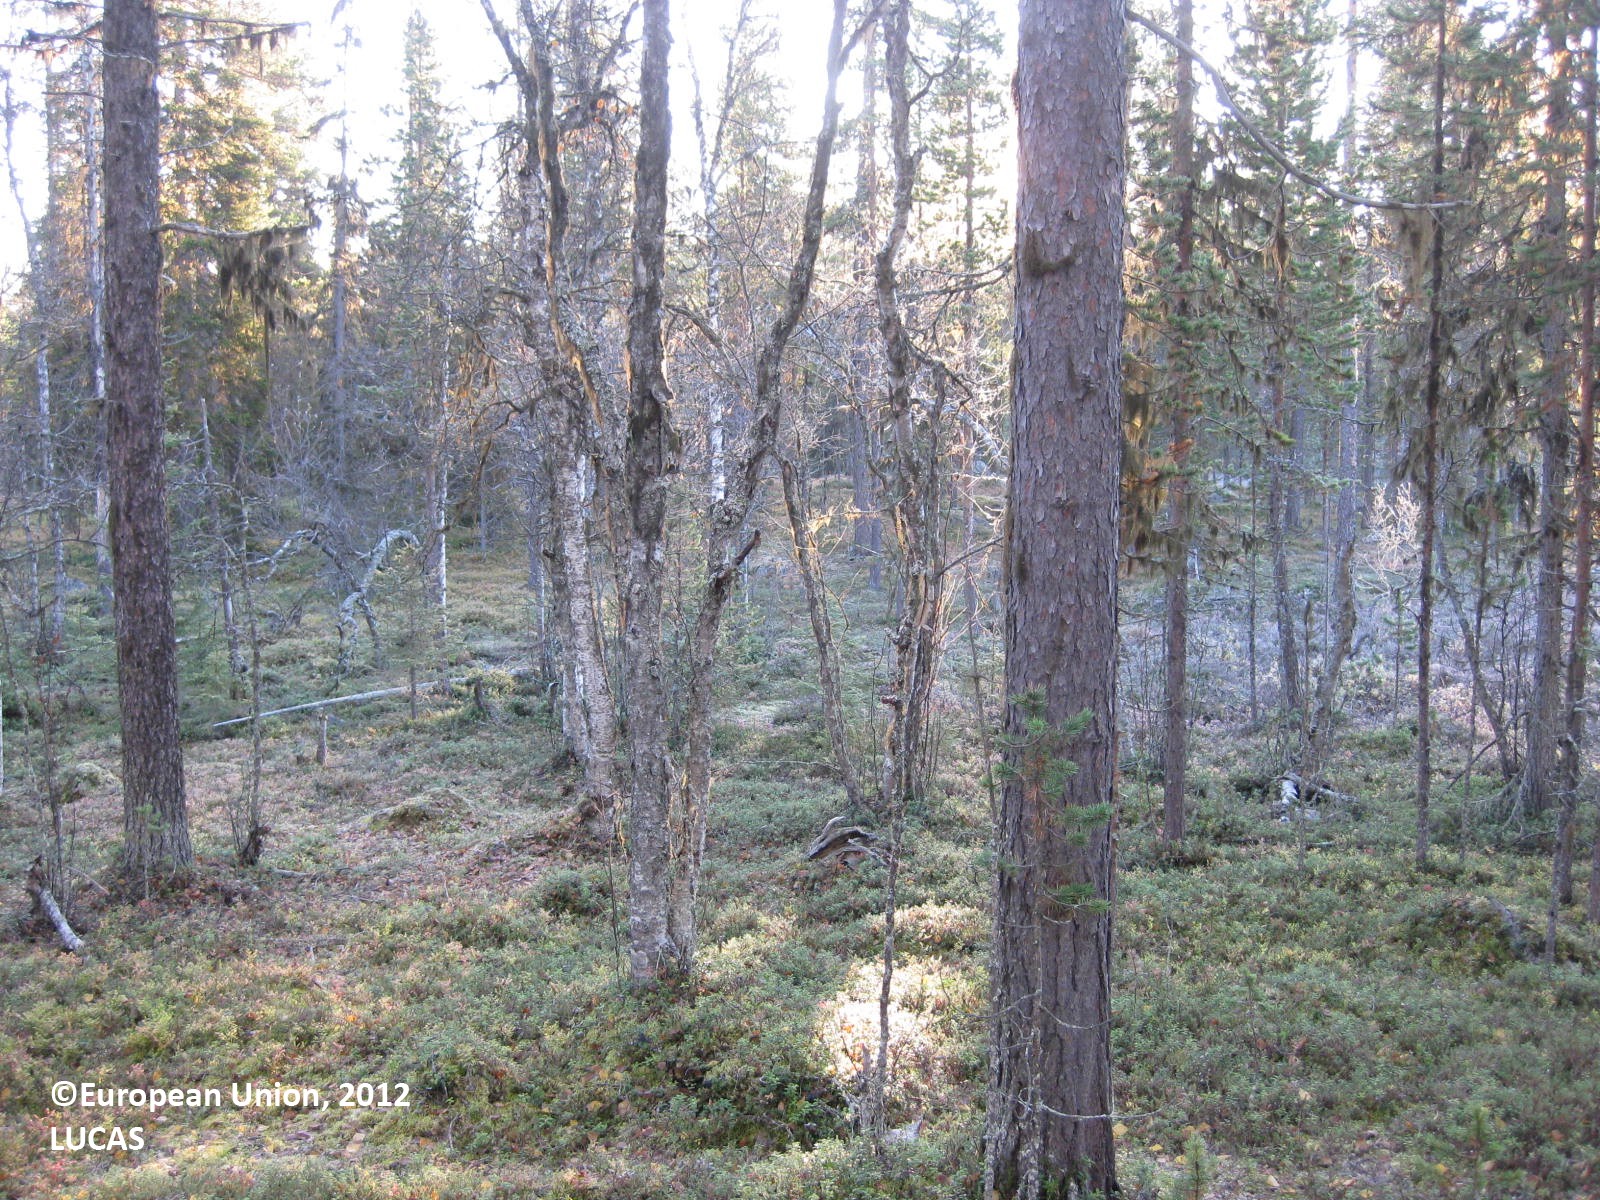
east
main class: Woodland
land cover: Other coniferous woodland
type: boreal forest
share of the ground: > 75 %
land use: Semi-natural and natural areas not in use
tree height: > 5 m
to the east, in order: Other coniferous woodland; Other mixed woodland; Other coniferous woodland; Pine dominated mixed woodland
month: September
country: FI
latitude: 67.9583
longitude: 24.0332
